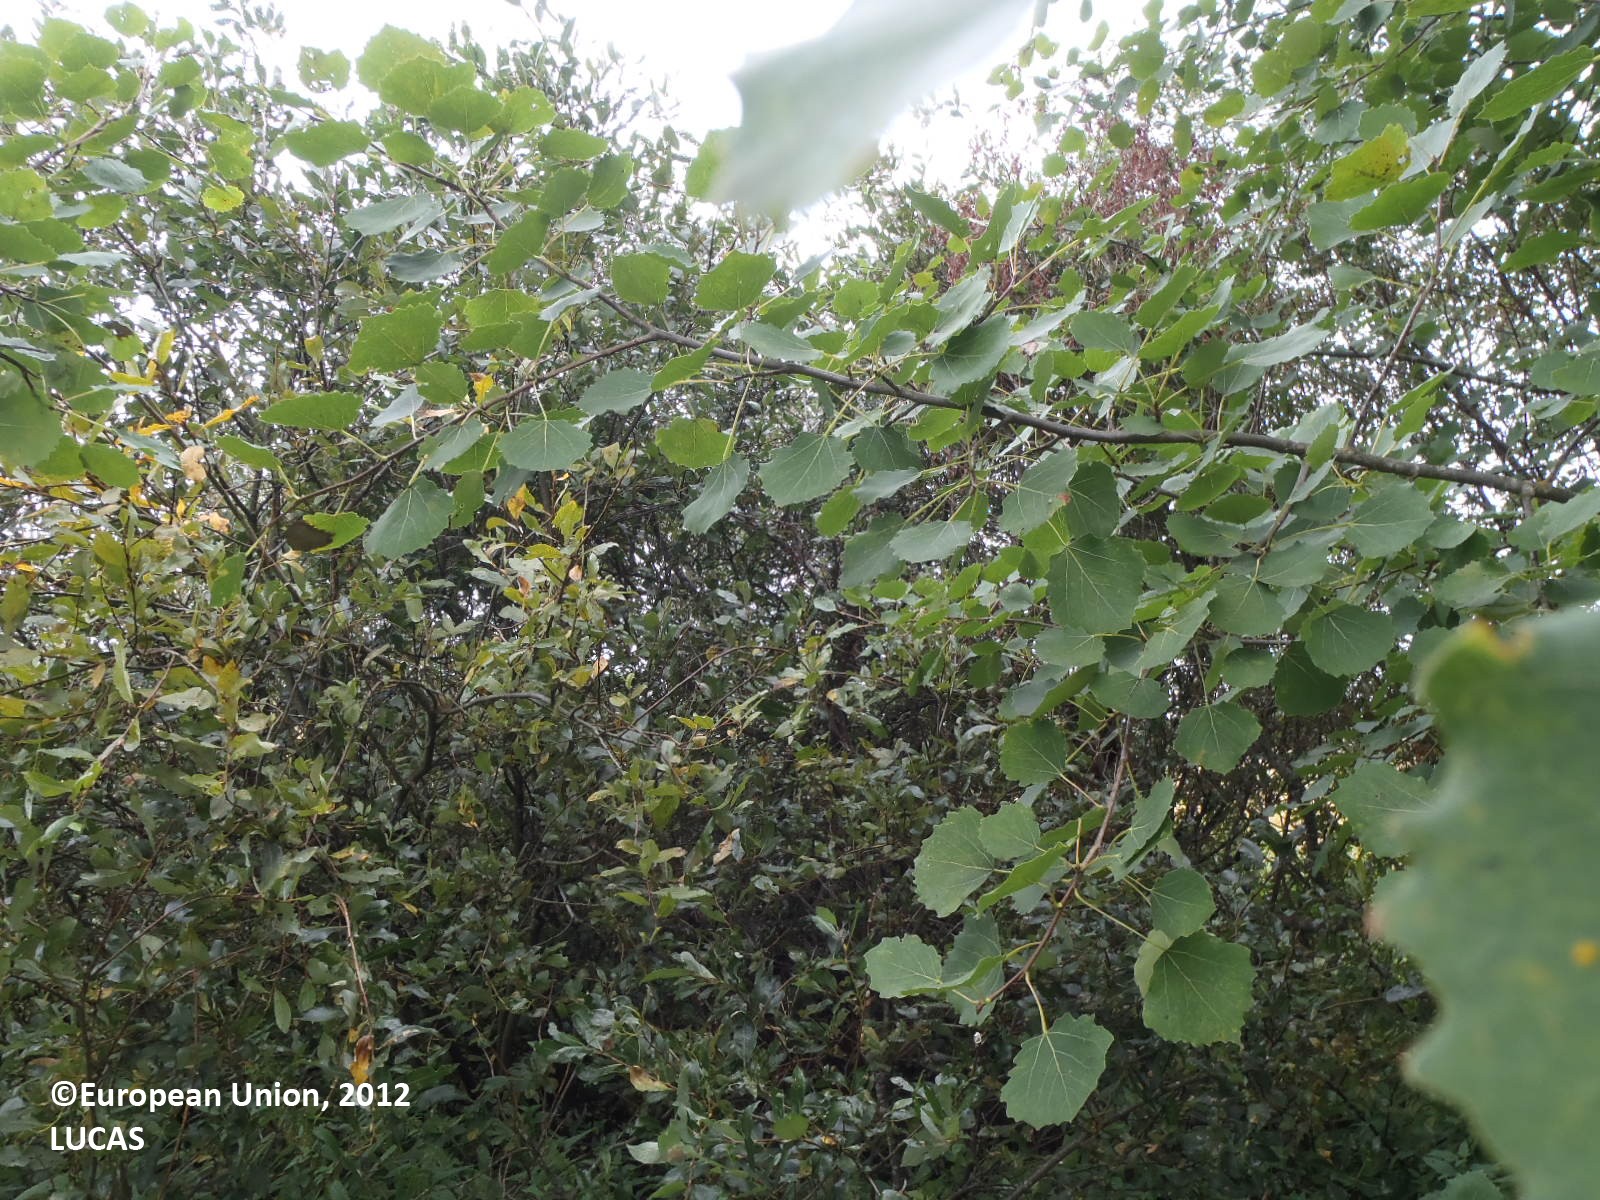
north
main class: Grassland
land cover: Grassland without tree/shrub cover
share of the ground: > 75 %
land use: Agriculture (excluding fallow land and kitchen gardens)
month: September
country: FI
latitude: 60.7424
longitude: 22.6353
